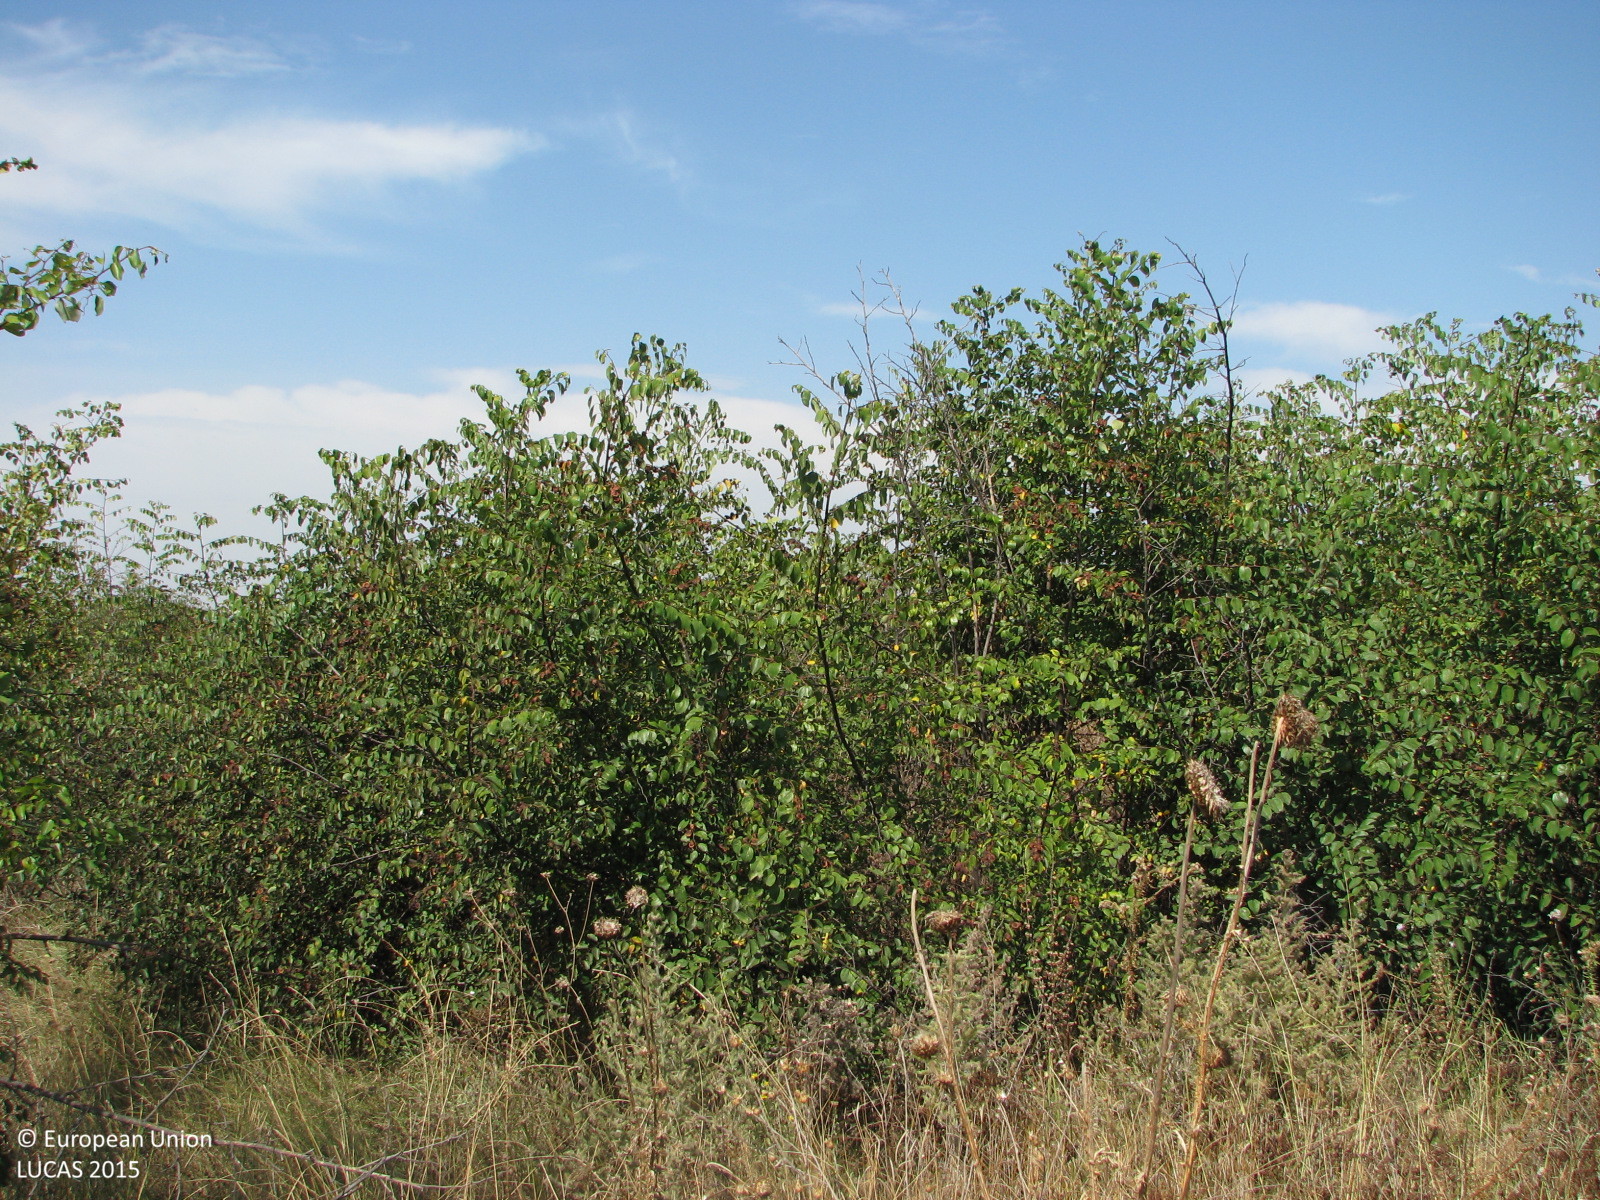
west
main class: Shrubland
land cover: Shrubland without tree cover
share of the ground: 50 - 75 %
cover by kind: shrubs 60 %, herbaceous plants 40 %
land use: Agriculture (excluding fallow land and kitchen gardens)
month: September
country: BG
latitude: 42.5493
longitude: 26.2224
